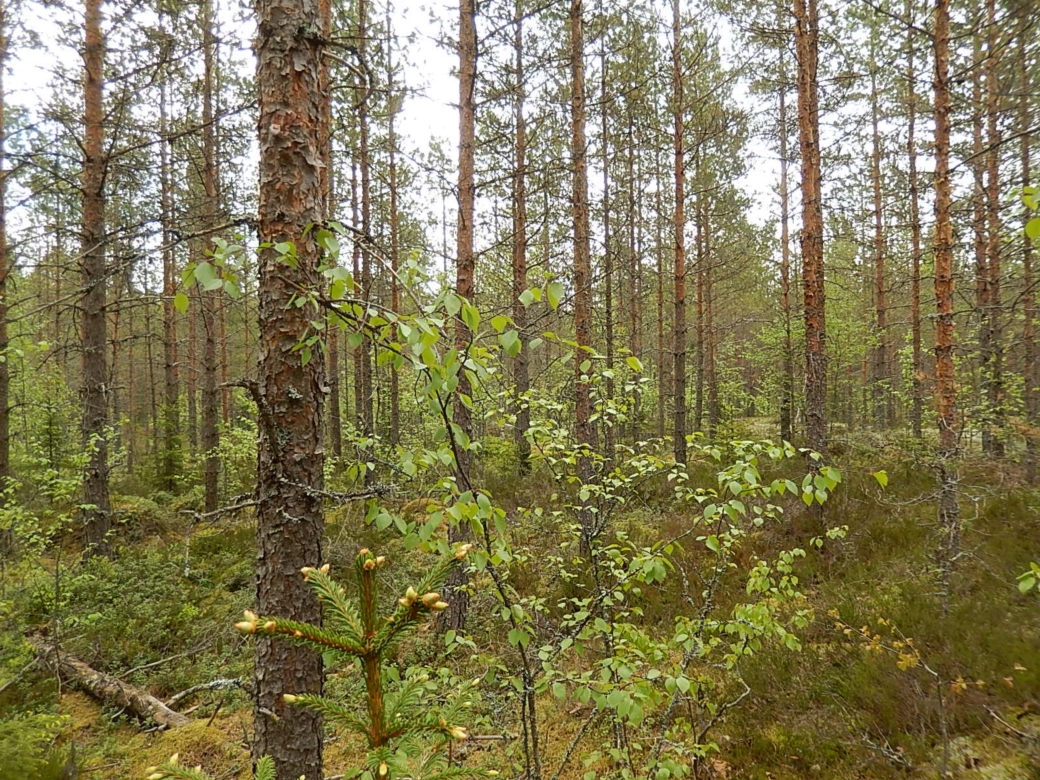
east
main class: Woodland
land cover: Pine dominated coniferous woodland
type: boreal forest
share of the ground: > 75 %
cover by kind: coniferous forest trees 75 %, lichens and mosses 20 %, broadleaved forest trees 5 %
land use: Forestry
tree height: > 5 m
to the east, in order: Pine dominated coniferous woodland; Pine dominated mixed woodland; Pine dominated coniferous woodland; Ditches and canals; Pine dominated coniferous woodland
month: June
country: FI
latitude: 61.9184
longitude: 21.6849
